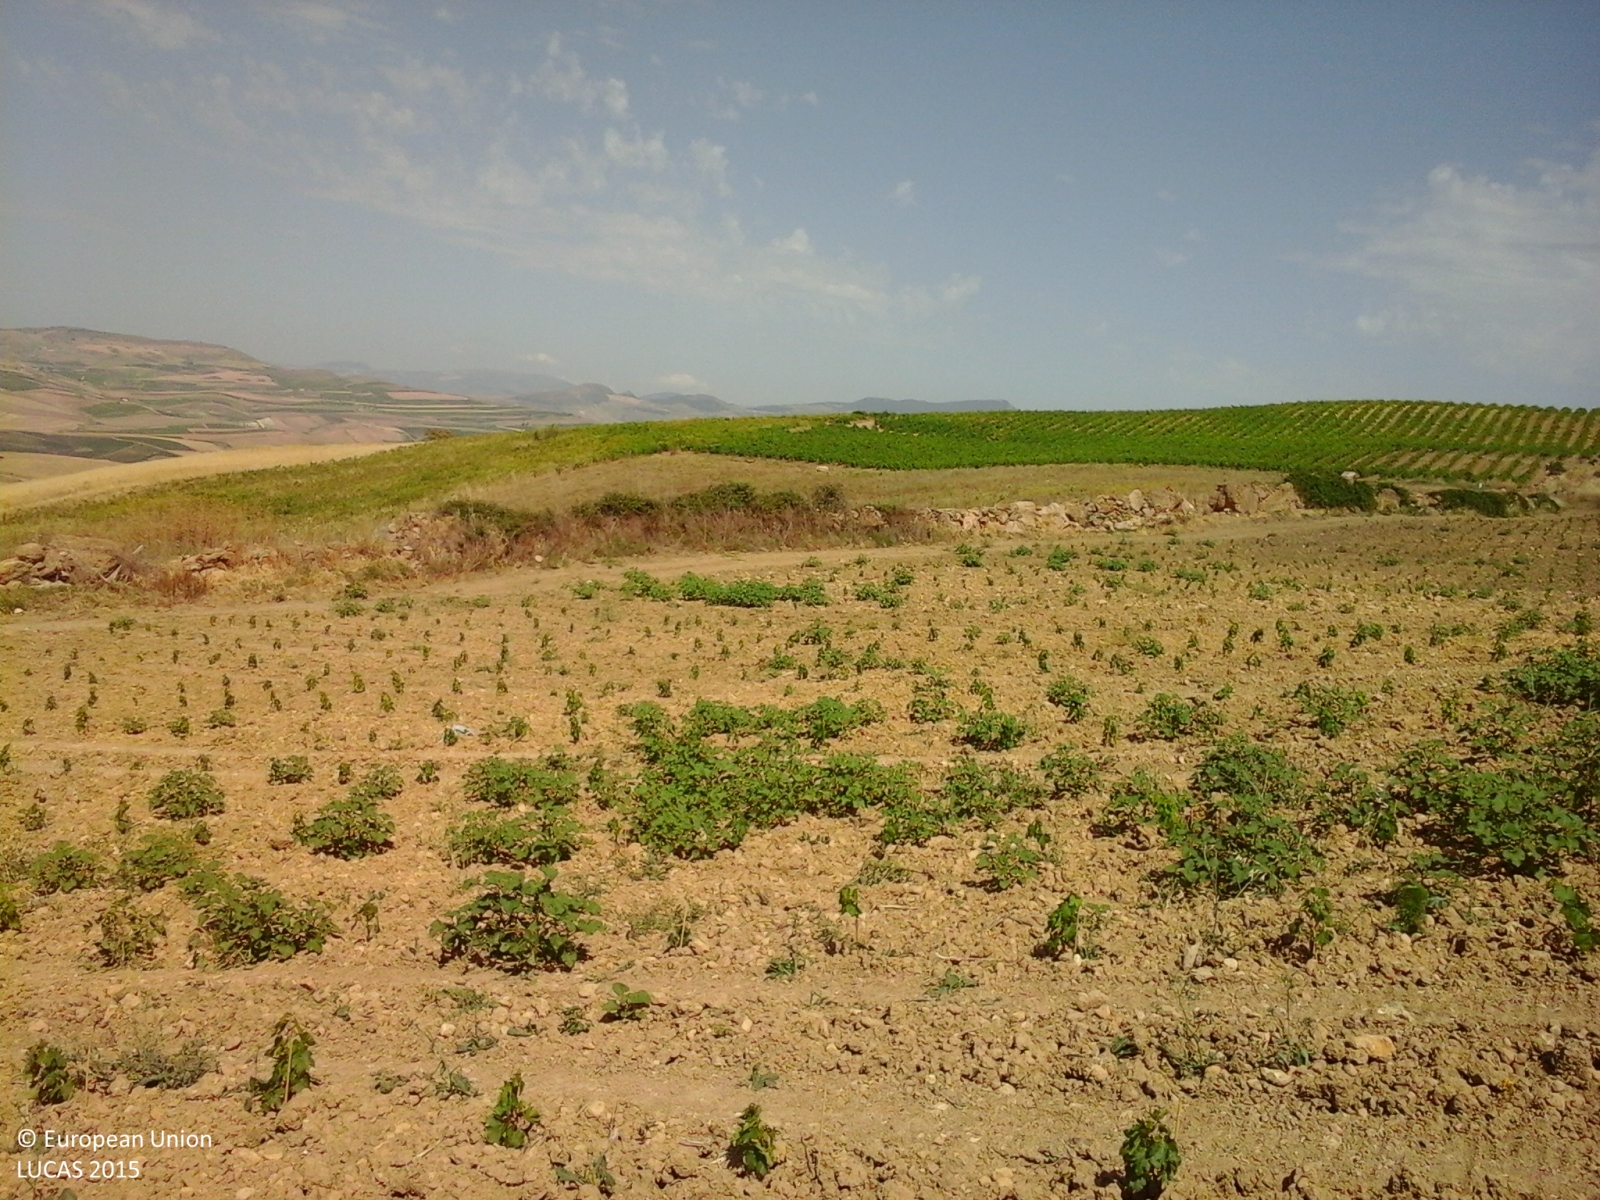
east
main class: Cropland
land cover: Vineyards
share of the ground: < 10 %
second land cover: Other bare soil
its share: > 75 %
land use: Agriculture (excluding fallow land and kitchen gardens)
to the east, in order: Vineyards; Other bare soil; Tracks; Grass margins; Ditches and canals; Grass margins; Dry stone walls; Tracks; Fences; Spontaneously vegetated surfaces; Fences; Vineyards
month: June
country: IT
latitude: 37.7182
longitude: 13.0065
